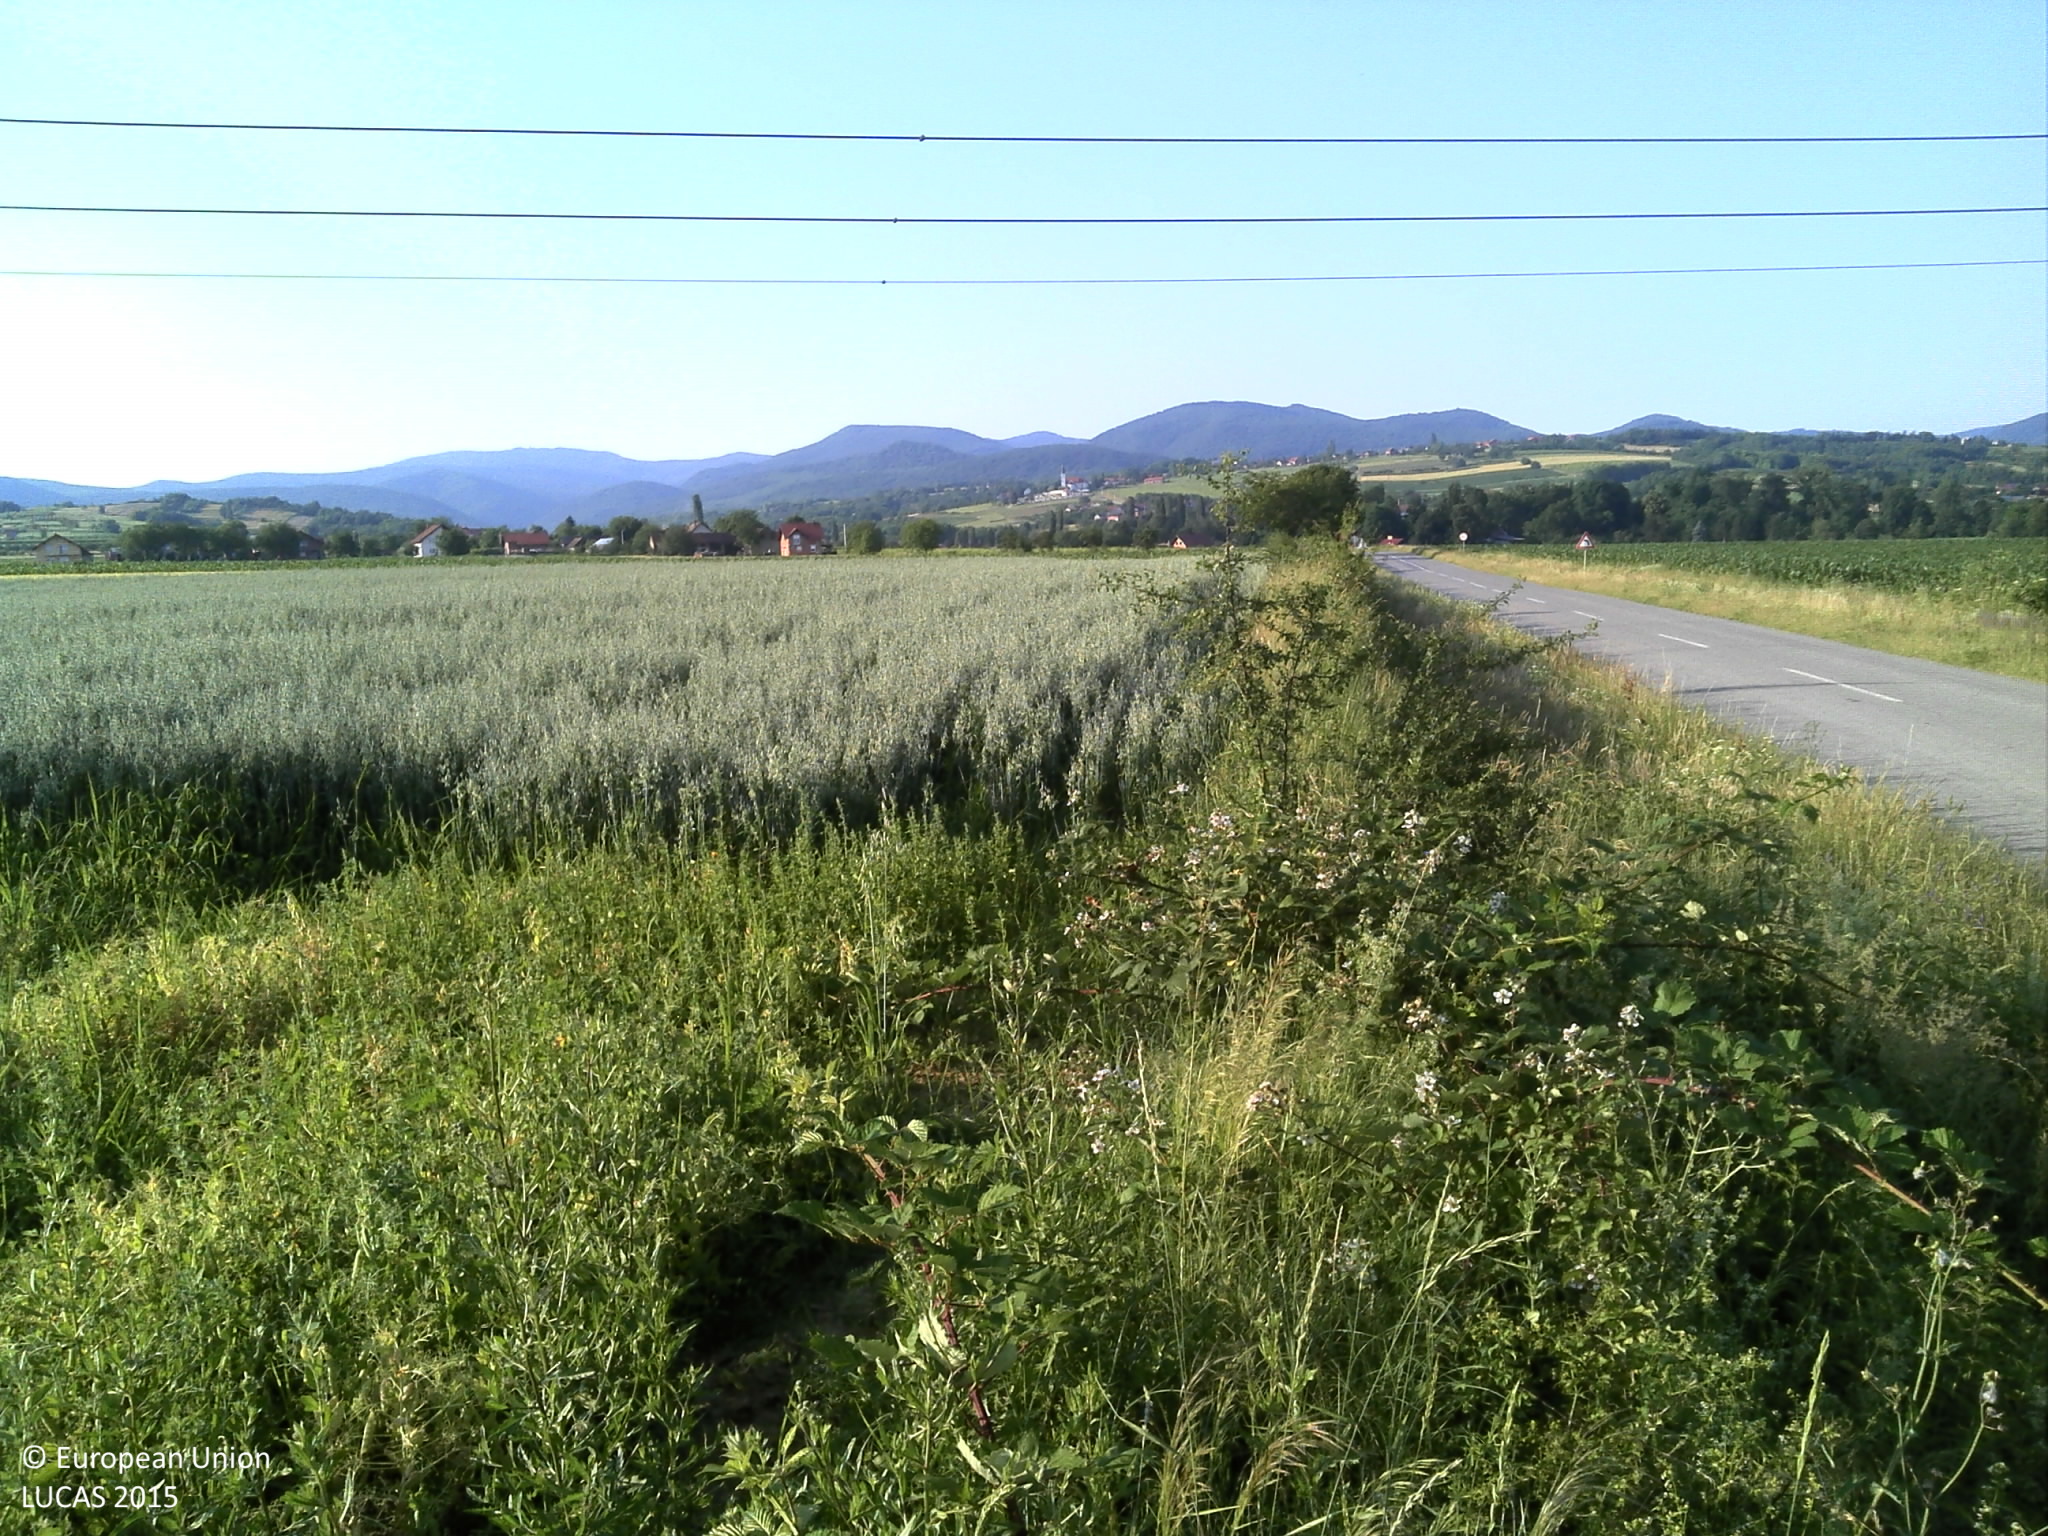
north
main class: Grassland
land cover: Spontaneously vegetated surfaces
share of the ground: > 75 %
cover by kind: herbaceous plants 100 %
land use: Agriculture (excluding fallow land and kitchen gardens)
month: June
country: HR
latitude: 45.4288
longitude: 17.6067
